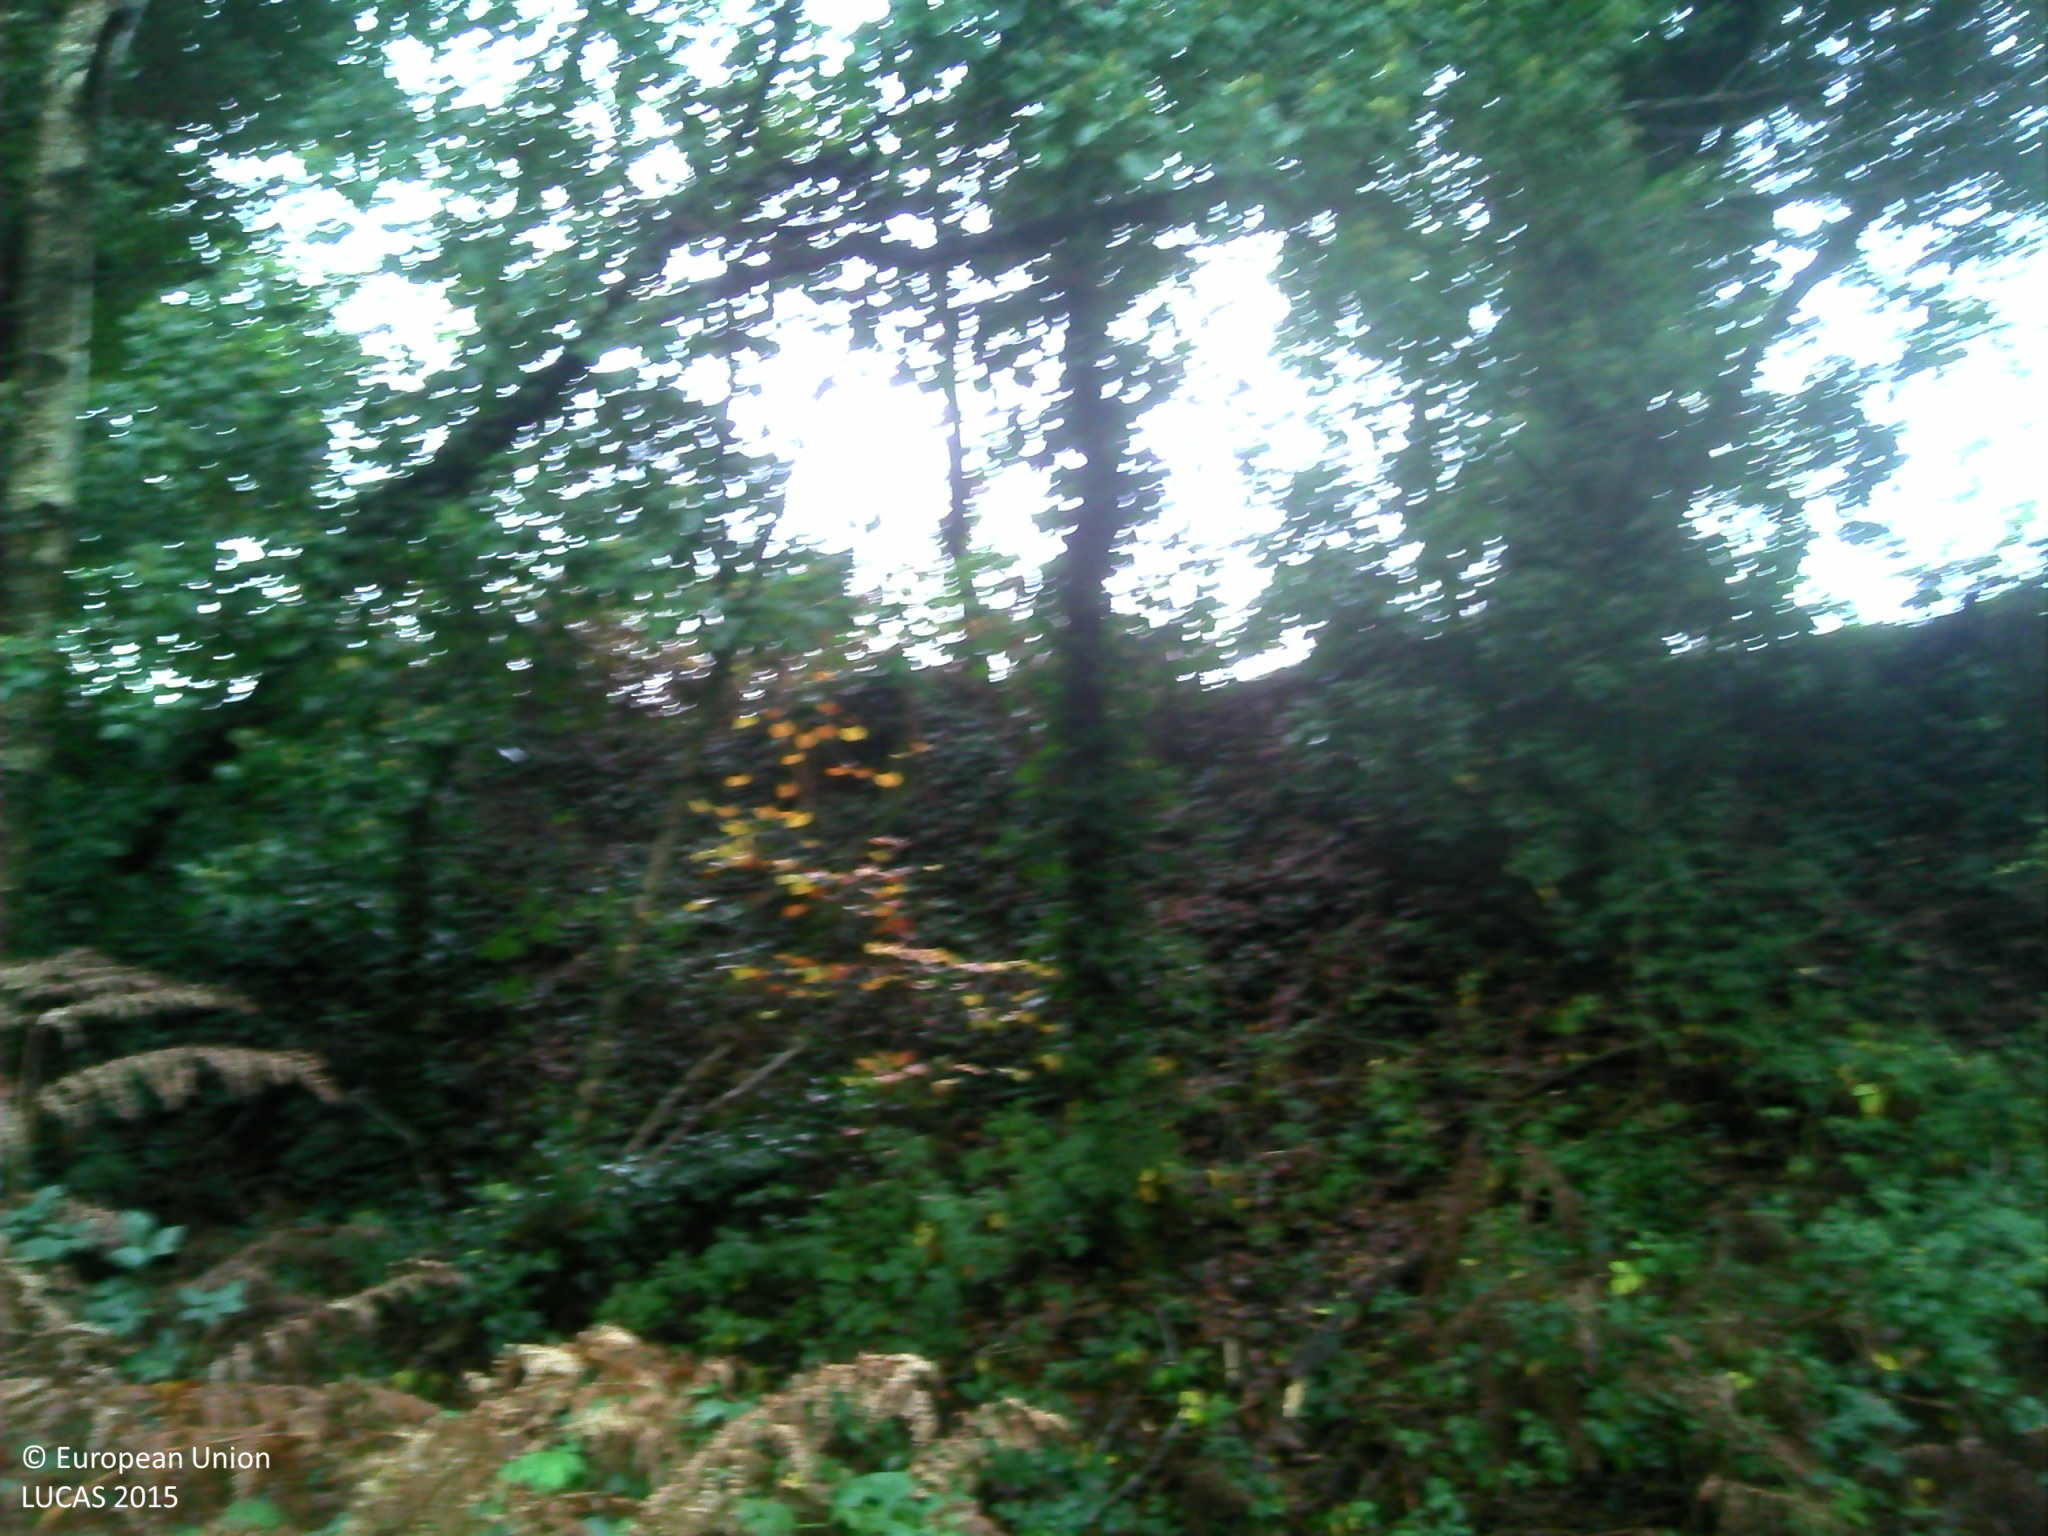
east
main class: Woodland
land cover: Broadleaved woodland
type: mesophytic deciduous forest
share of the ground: > 75 %
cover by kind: broadleaved forest trees 100 %
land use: Forestry
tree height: > 5 m
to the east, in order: Broadleaved woodland; Fences; Grassland without tree/shrub cover; Fences; Broadleaved woodland
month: November
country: FR
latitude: 48.0032
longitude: -3.2476
